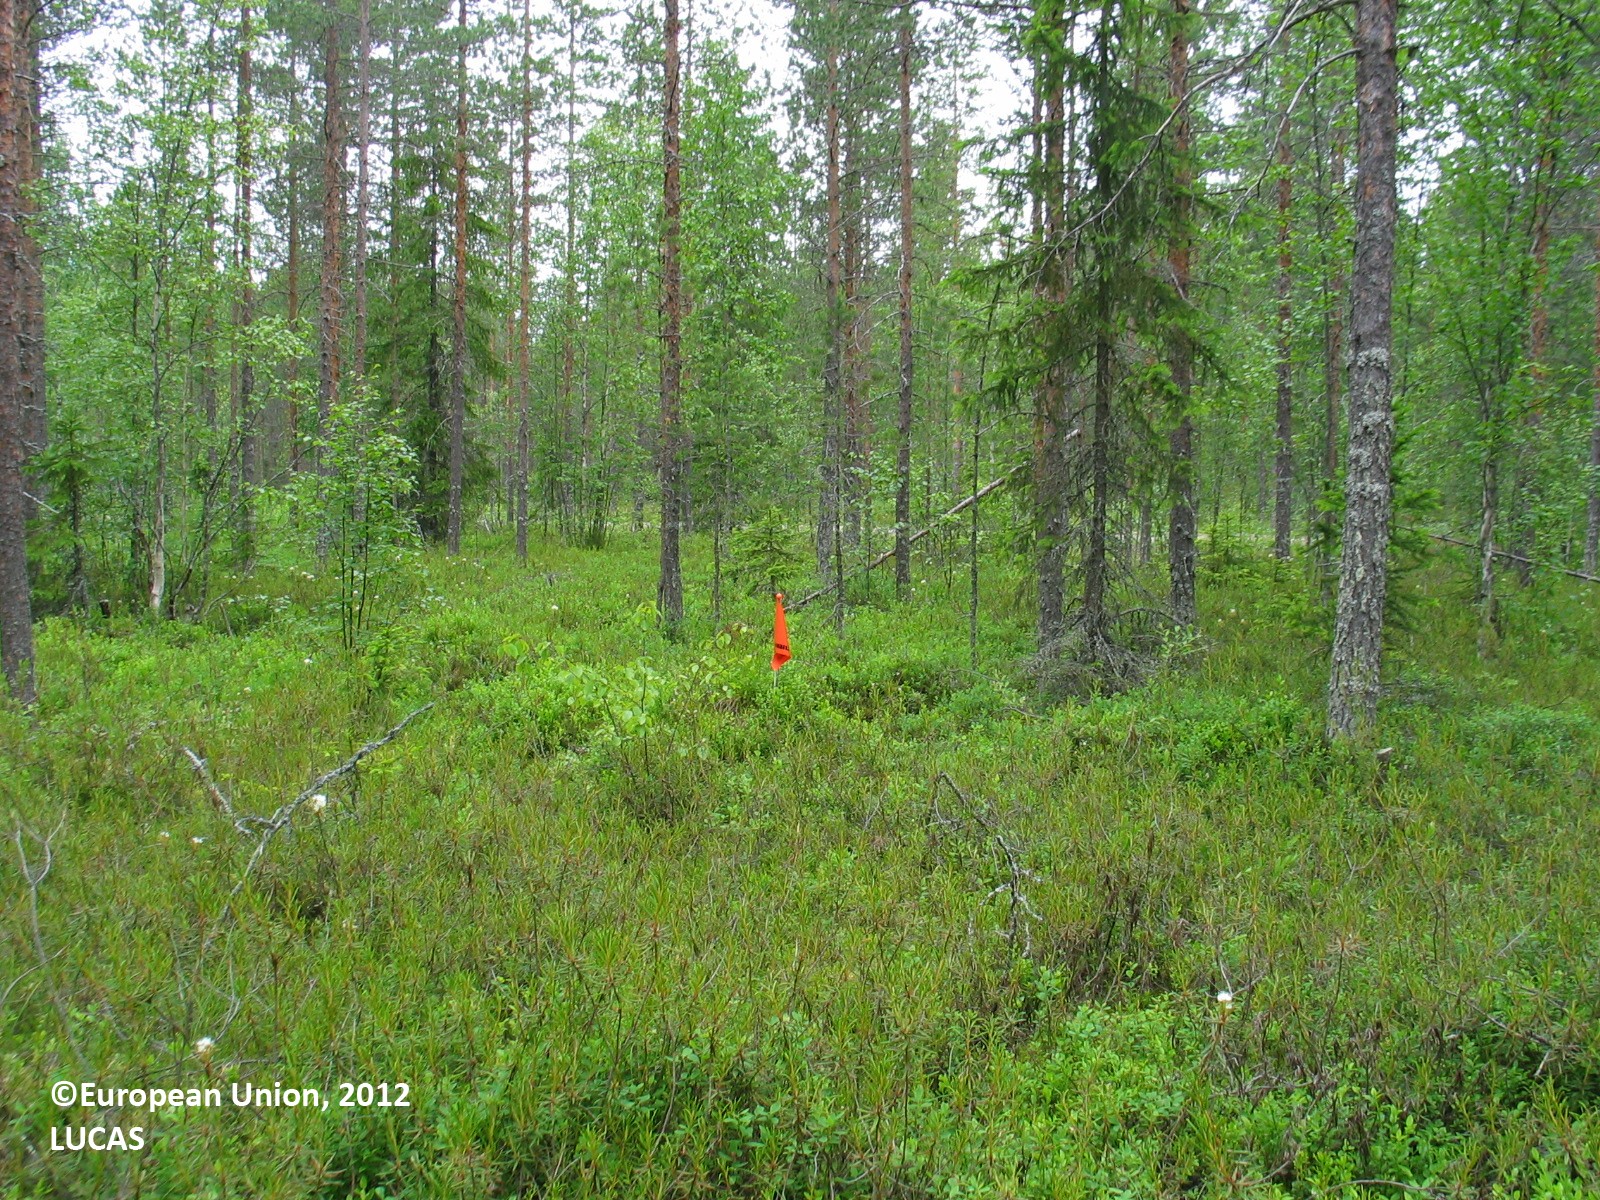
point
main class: Woodland
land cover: Pine dominated coniferous woodland
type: mire and swamp forests
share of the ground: 25 - 50 %
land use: Forestry
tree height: > 5 m
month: July
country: FI
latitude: 64.6474
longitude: 26.5879
